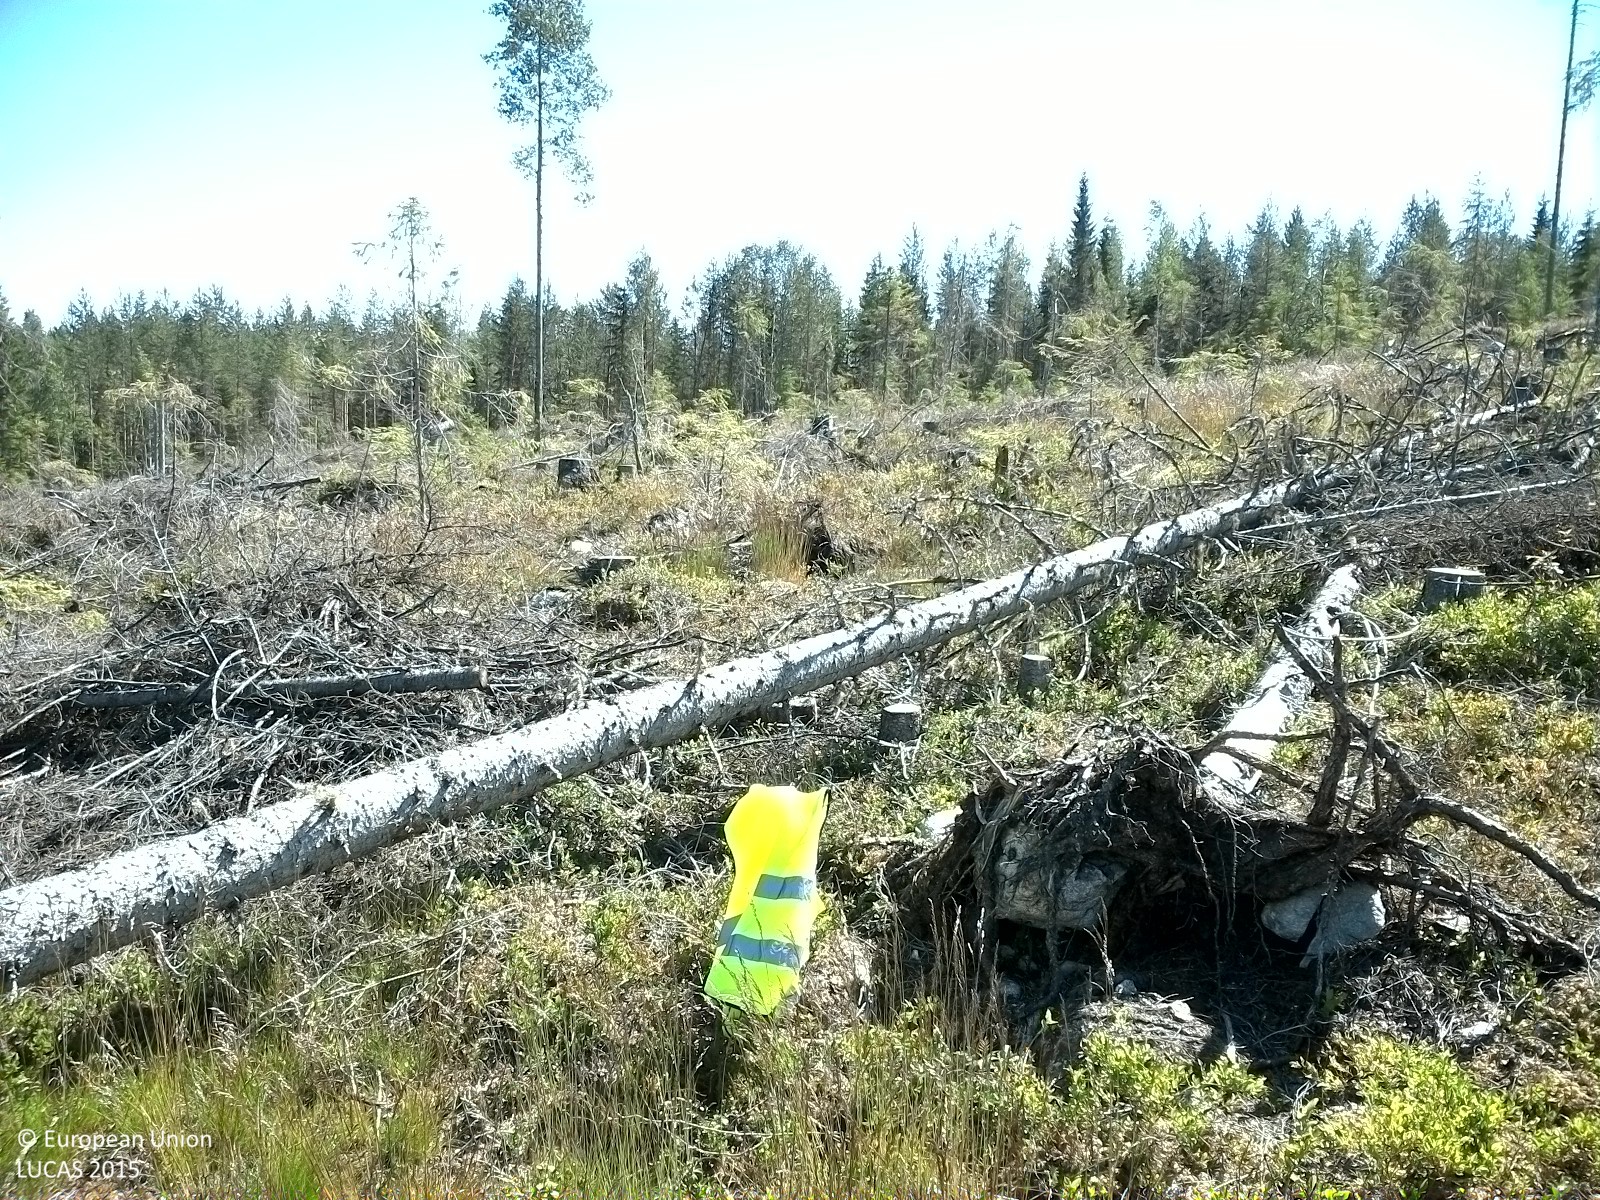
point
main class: Woodland
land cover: Spruce dominated mixed woodland
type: boreal forest
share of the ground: 10 - 25 %
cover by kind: herbaceous plants 30 %, unconsolidated bare surface 30 %, shrubs 20 %, coniferous forest trees 15 %, broadleaved forest trees 5 %
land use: Forestry
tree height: < 5 m
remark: Clear cut
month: July
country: SE
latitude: 62.2571
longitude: 16.8551
